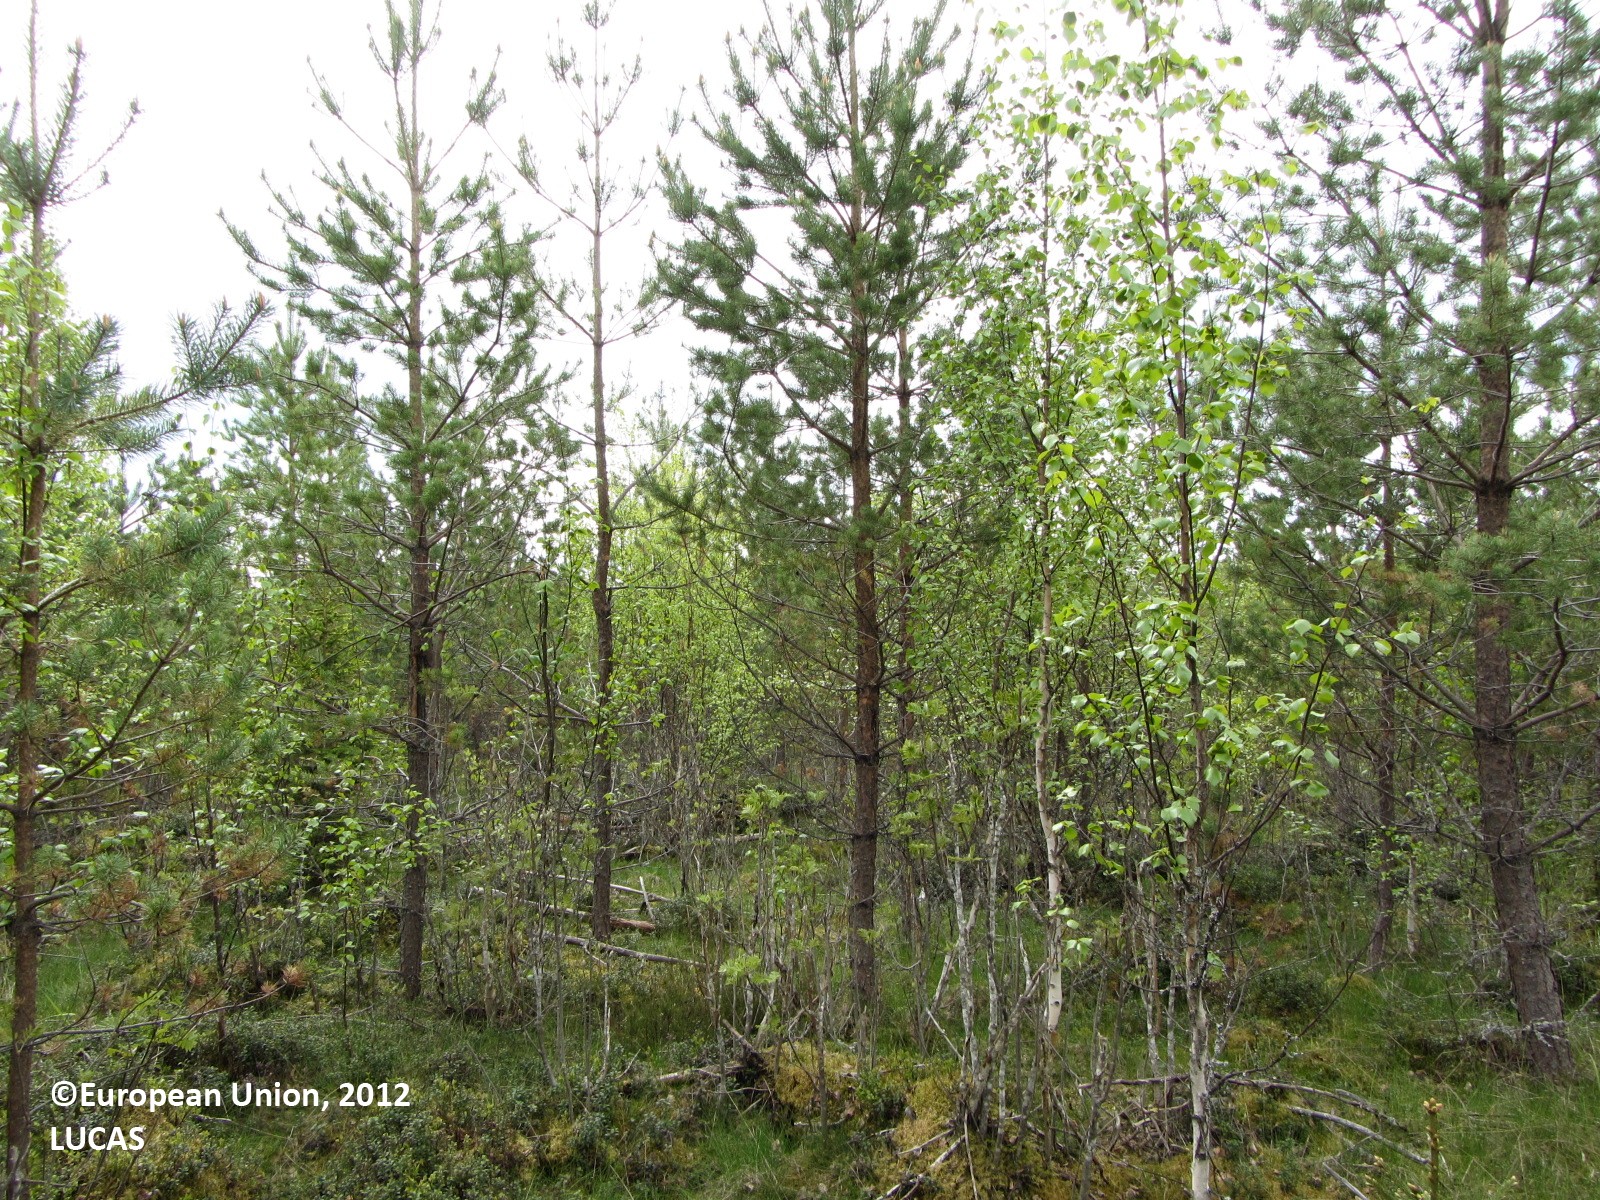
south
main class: Woodland
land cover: Pine dominated mixed woodland
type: boreal forest
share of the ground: > 75 %
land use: Forestry
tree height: < 5 m
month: June
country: FI
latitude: 63.8165
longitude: 24.7266
